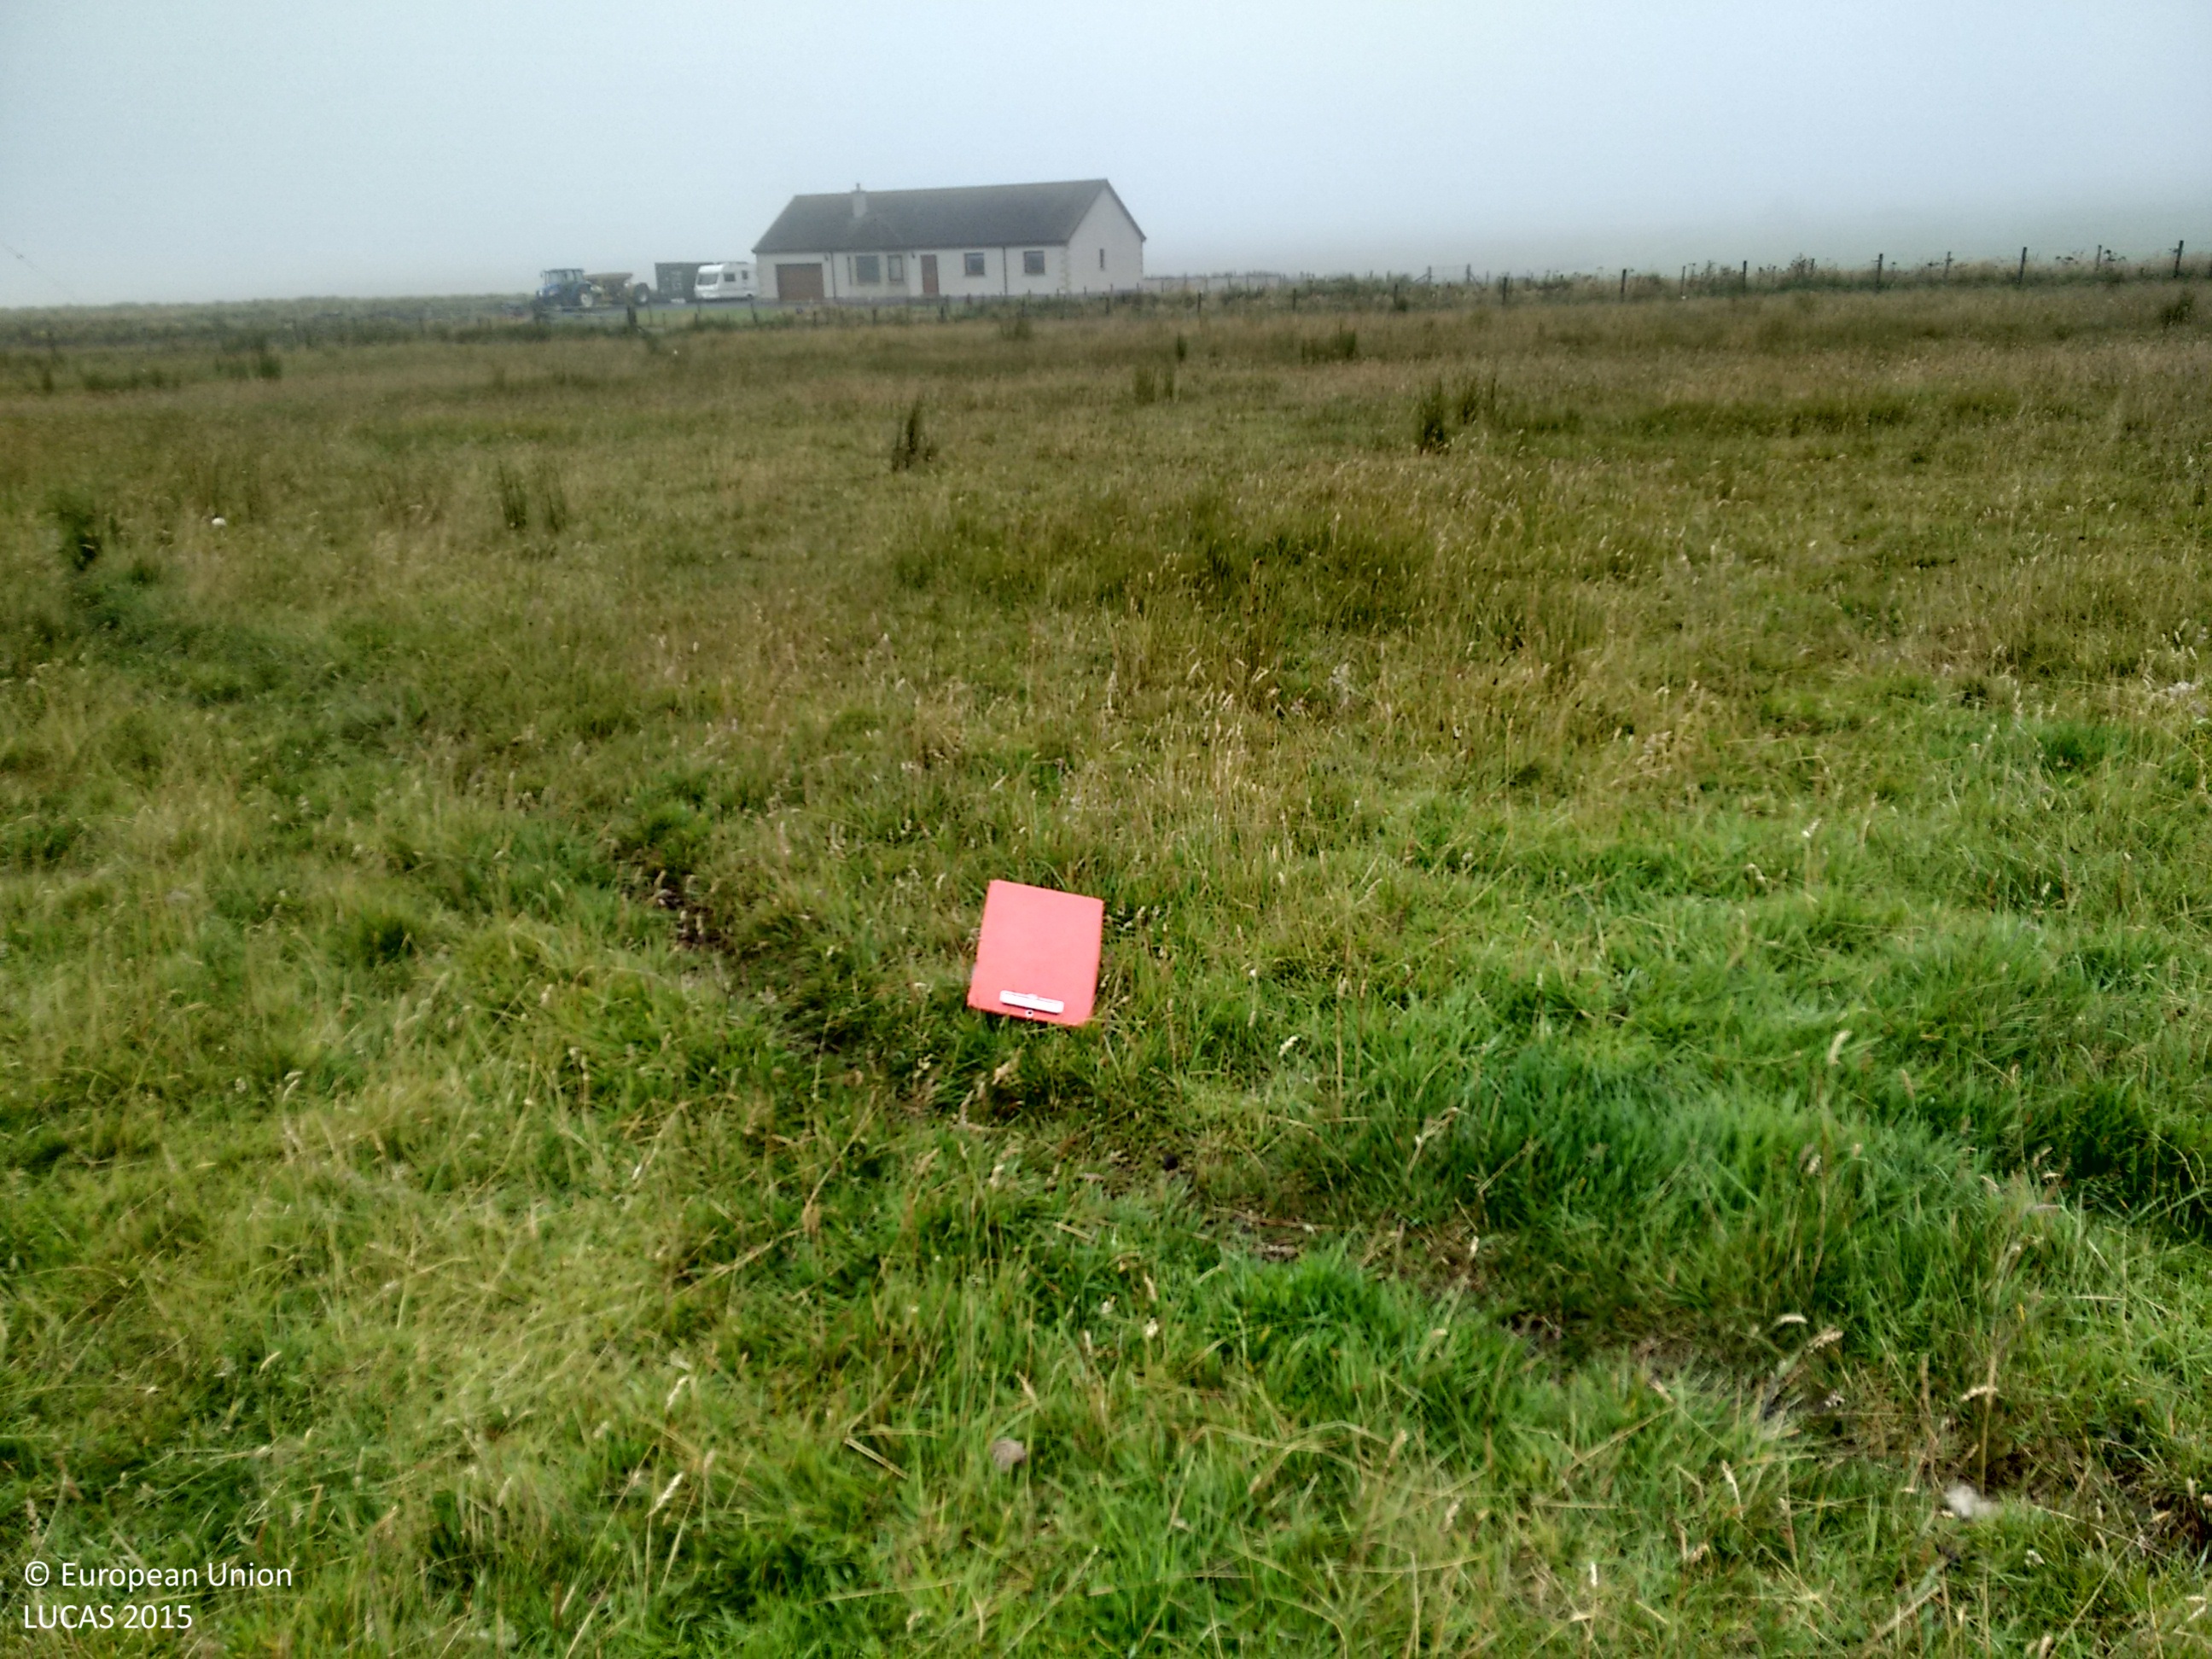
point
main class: Grassland
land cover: Grassland without tree/shrub cover
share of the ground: > 75 %
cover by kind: herbaceous plants 100 %
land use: Agriculture (excluding fallow land and kitchen gardens)
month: August
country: GB
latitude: 58.3259
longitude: -3.2600
